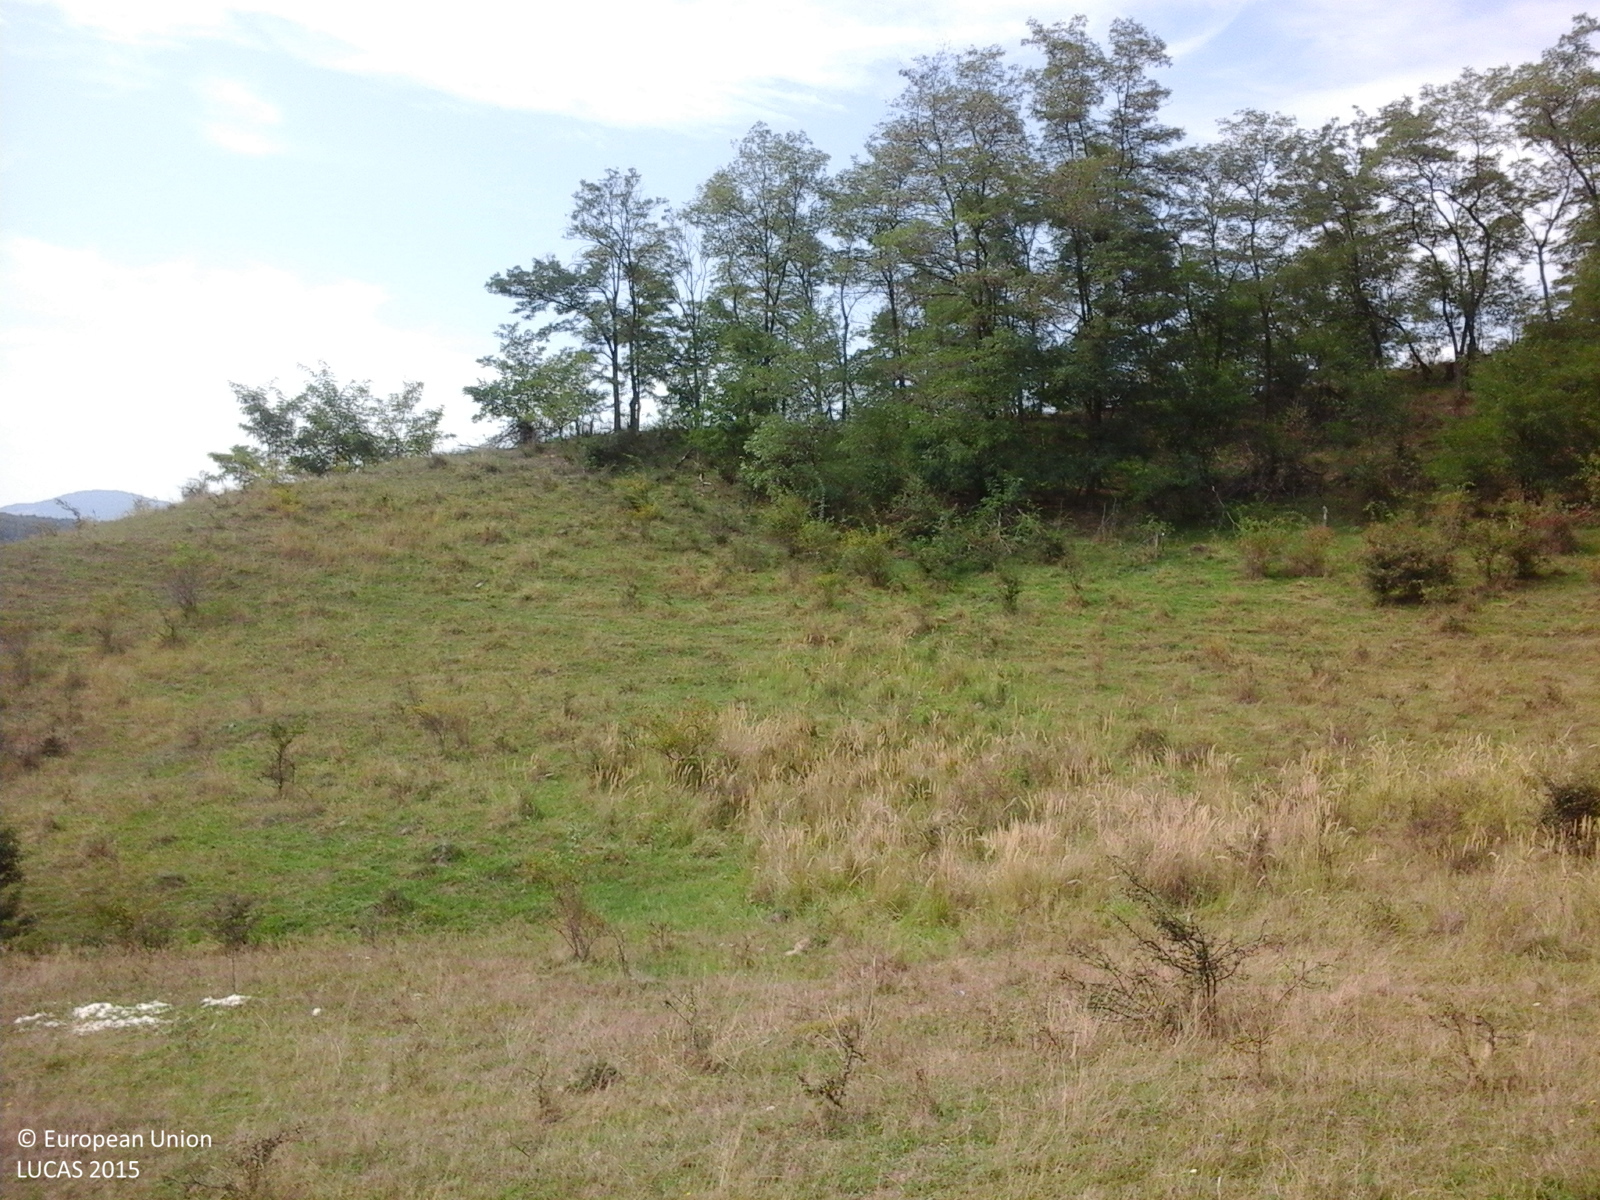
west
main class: Grassland
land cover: Grassland with sparse tree/shrub cover
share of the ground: > 75 %
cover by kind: herbaceous plants 85 %, shrubs 10 %, broadleaved forest trees 5 %
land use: Agriculture (excluding fallow land and kitchen gardens)
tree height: < 5 m
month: September
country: RO
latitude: 46.9602
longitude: 22.9796
